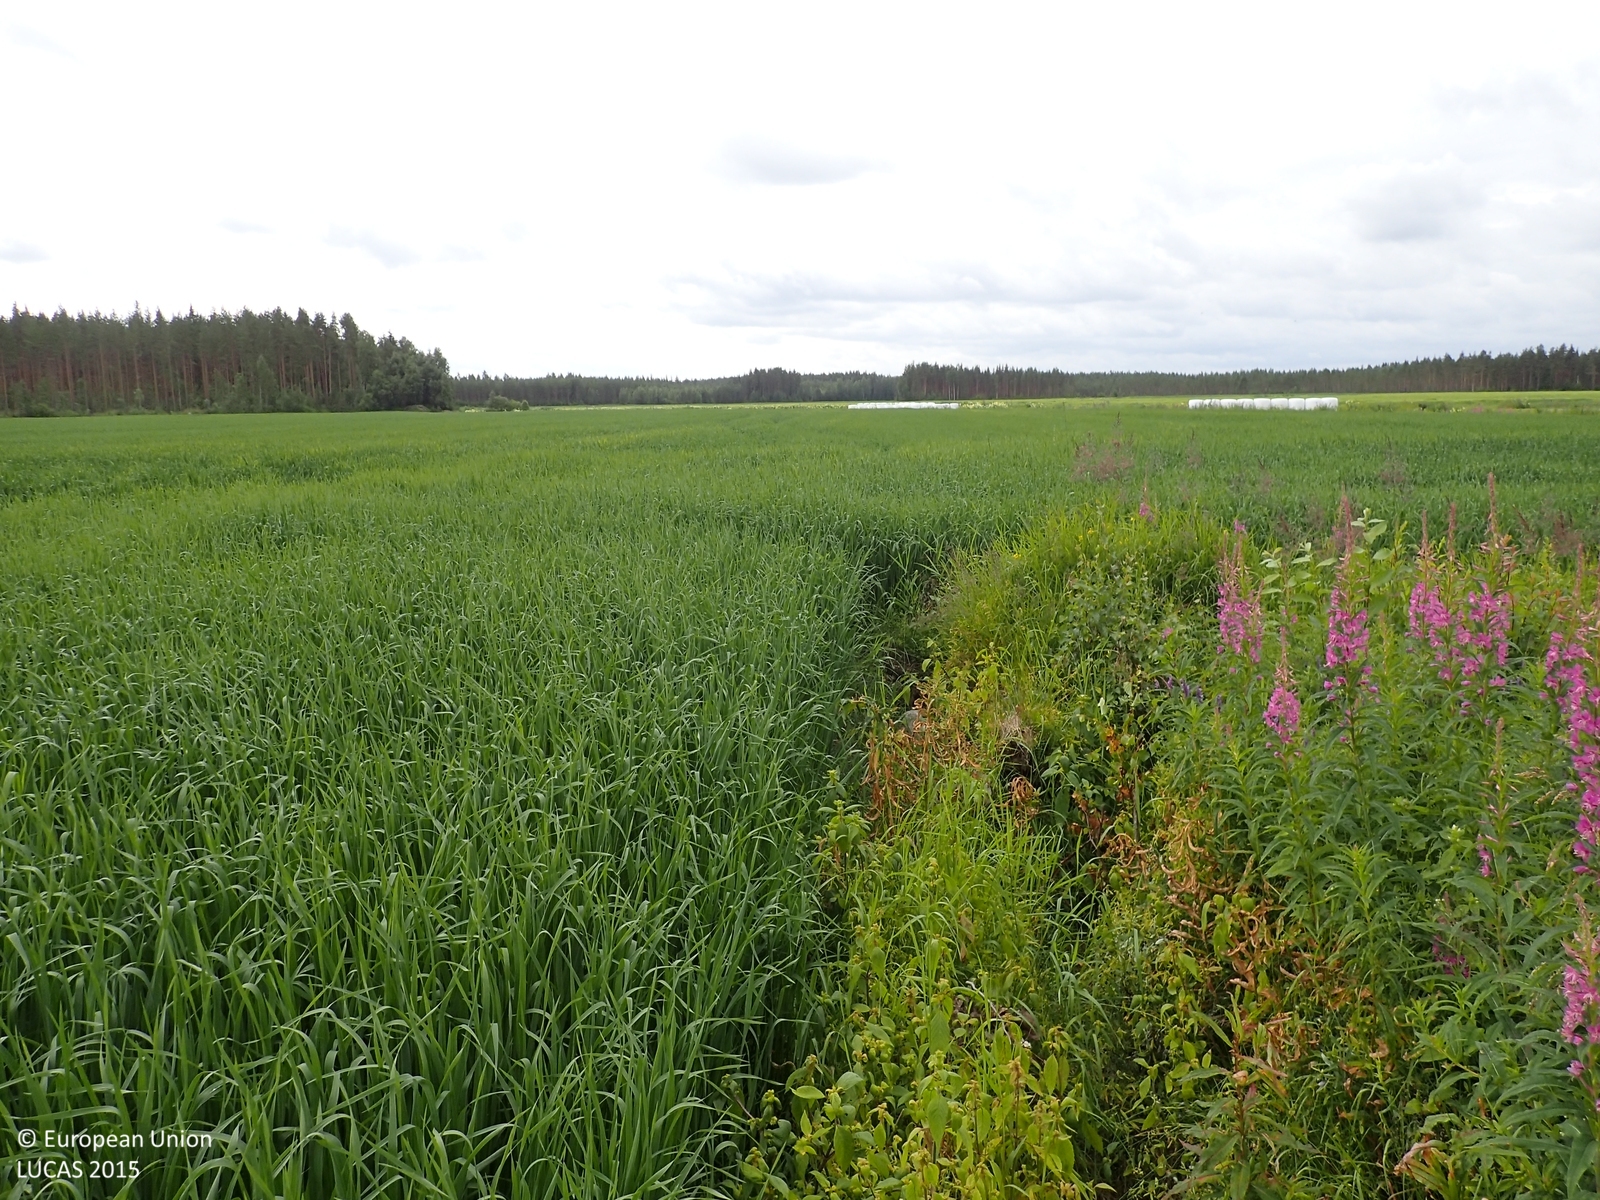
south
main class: Cropland
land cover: Oats
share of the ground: > 75 %
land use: Agriculture (excluding fallow land and kitchen gardens)
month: July
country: FI
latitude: 62.9163
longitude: 23.3139
